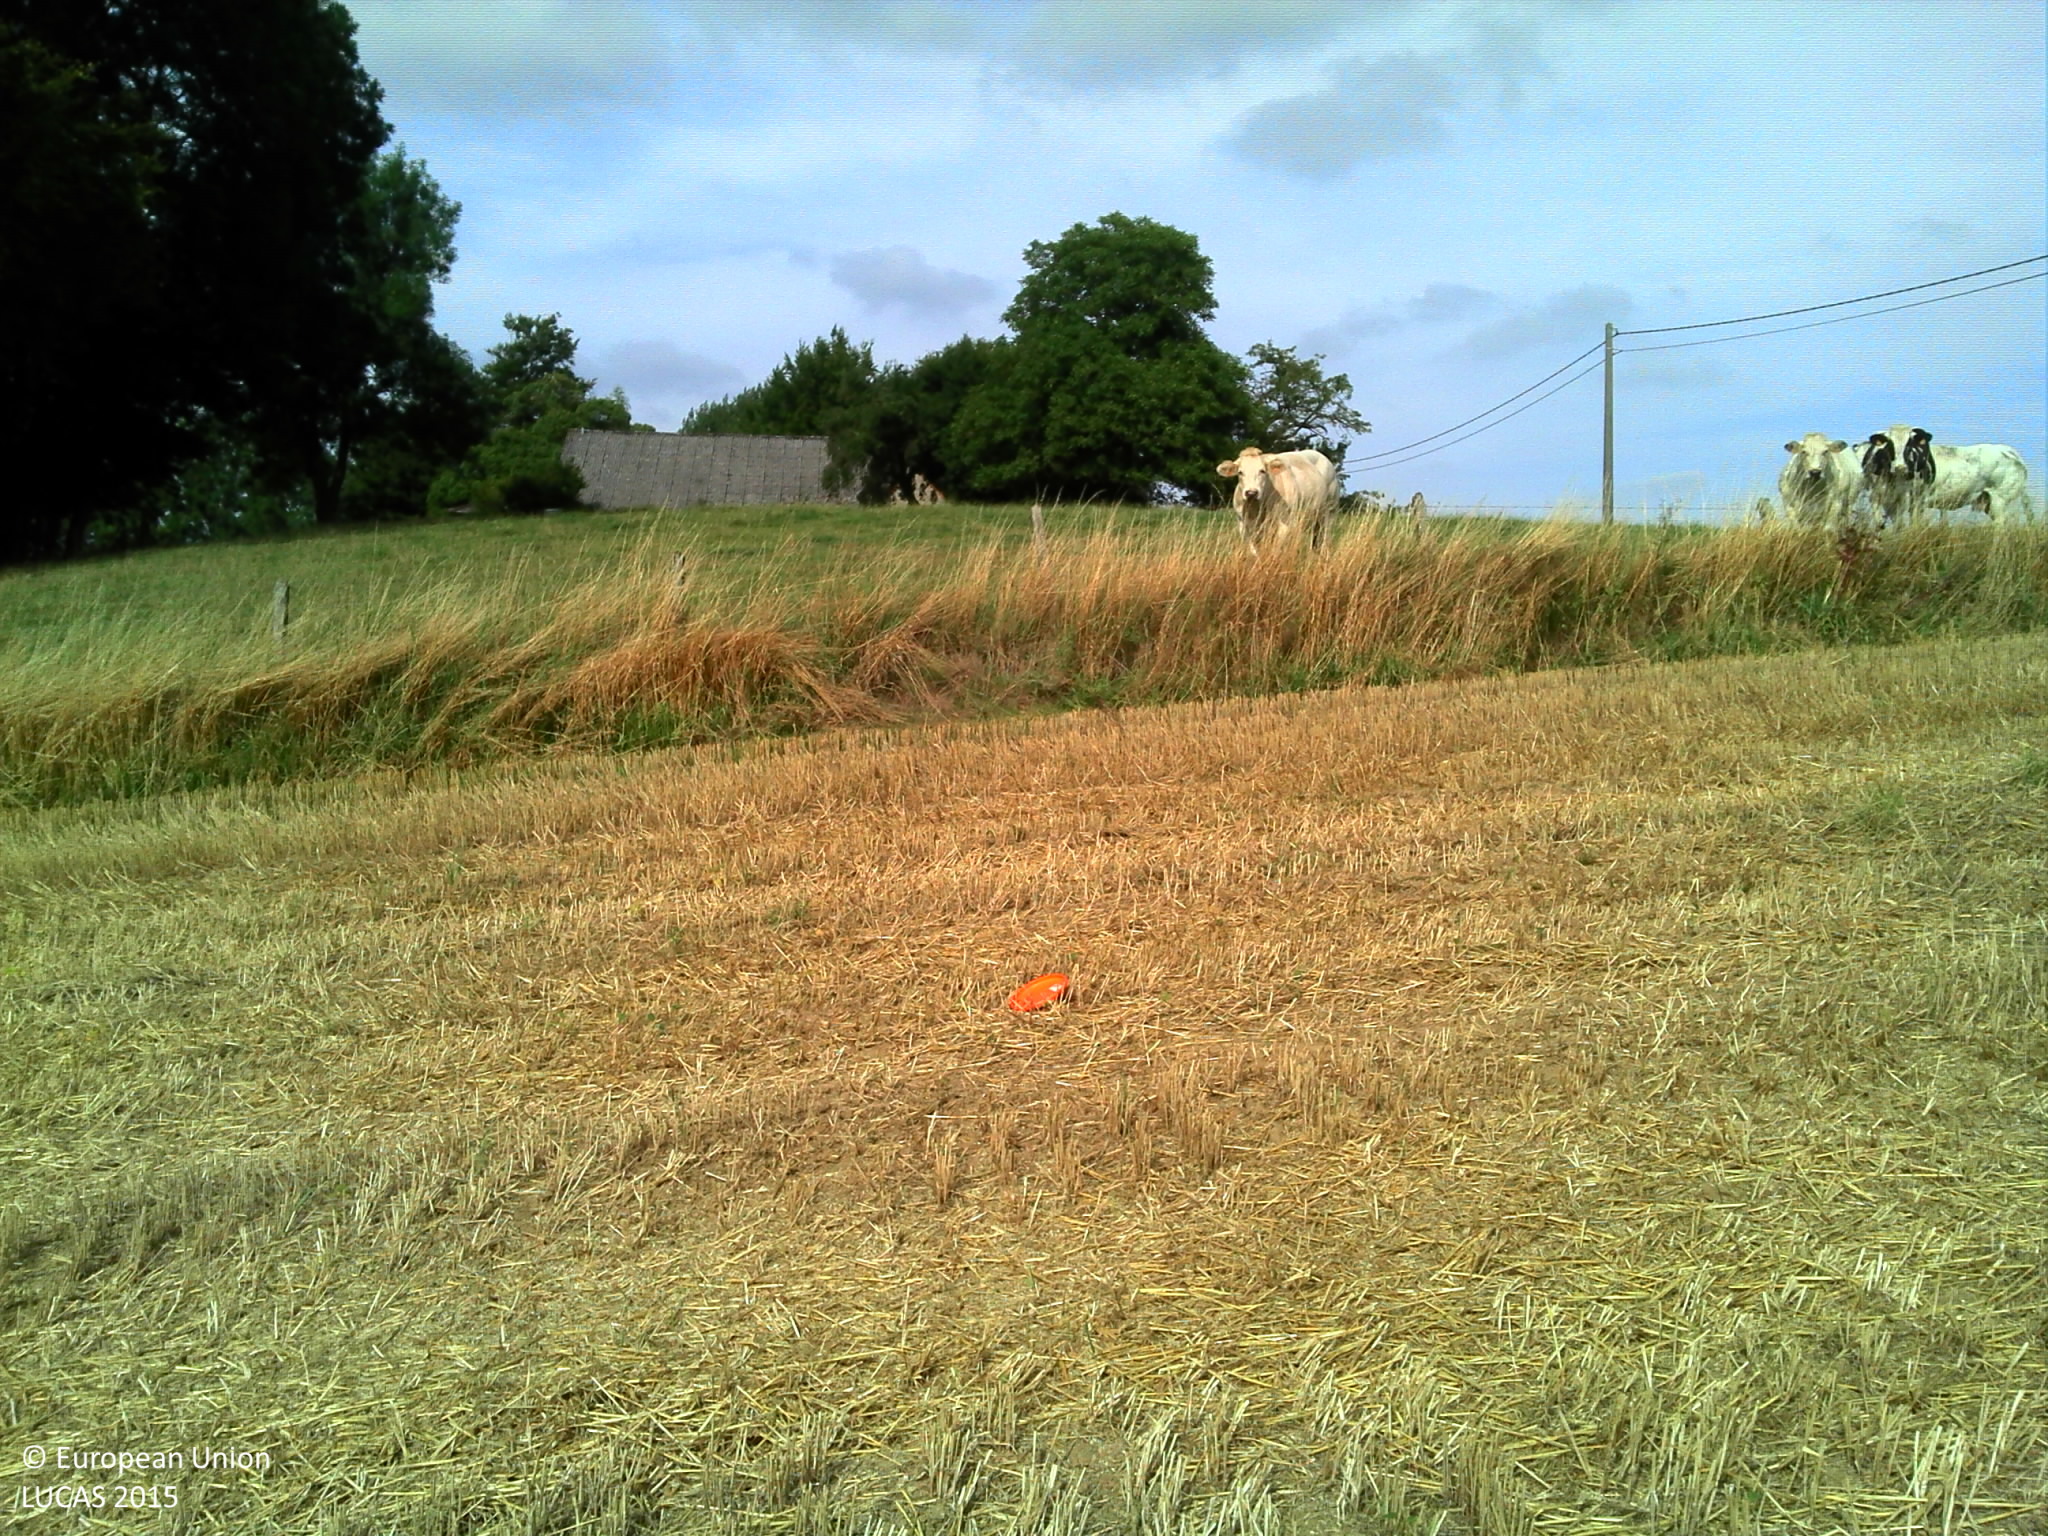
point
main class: Cropland
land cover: Common wheat
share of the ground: > 75 %
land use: Agriculture (excluding fallow land and kitchen gardens)
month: August
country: BE
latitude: 50.7129
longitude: 3.6908
